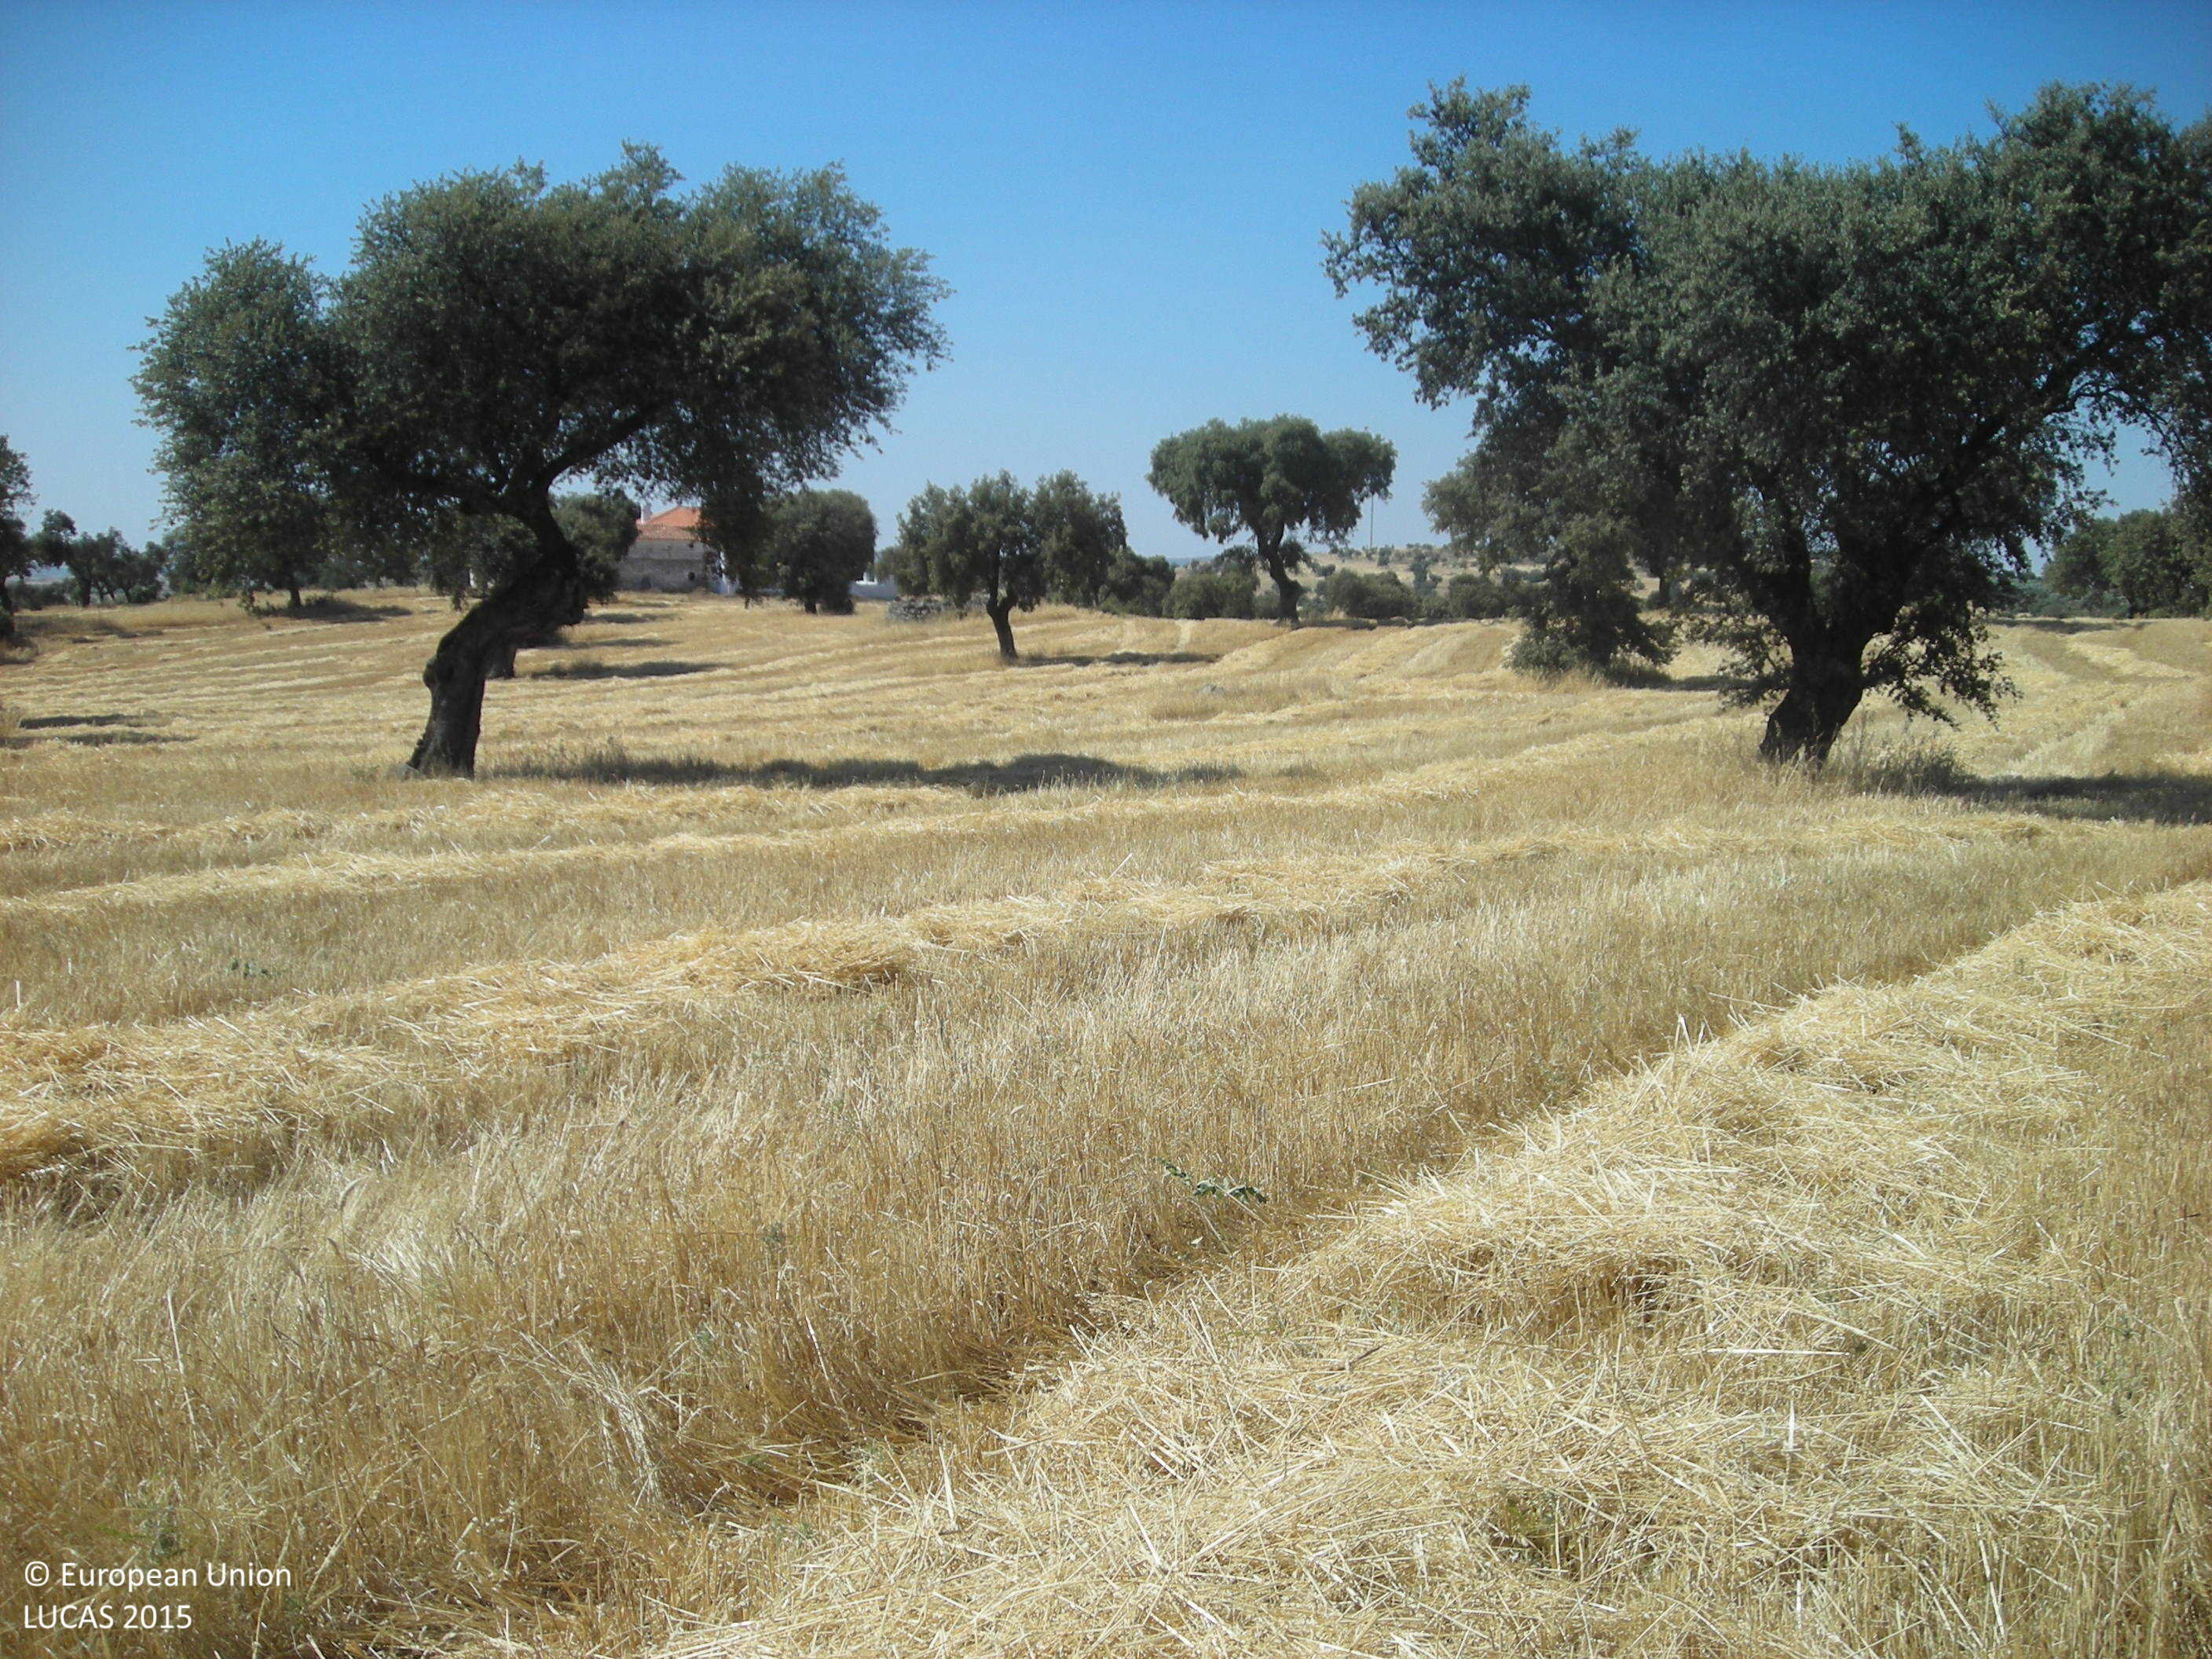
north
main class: Cropland
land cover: Mixed cereals for fodder
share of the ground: > 75 %
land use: Agriculture (excluding fallow land and kitchen gardens)
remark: Harvested field
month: June
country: ES
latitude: 38.6195
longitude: -5.7421
